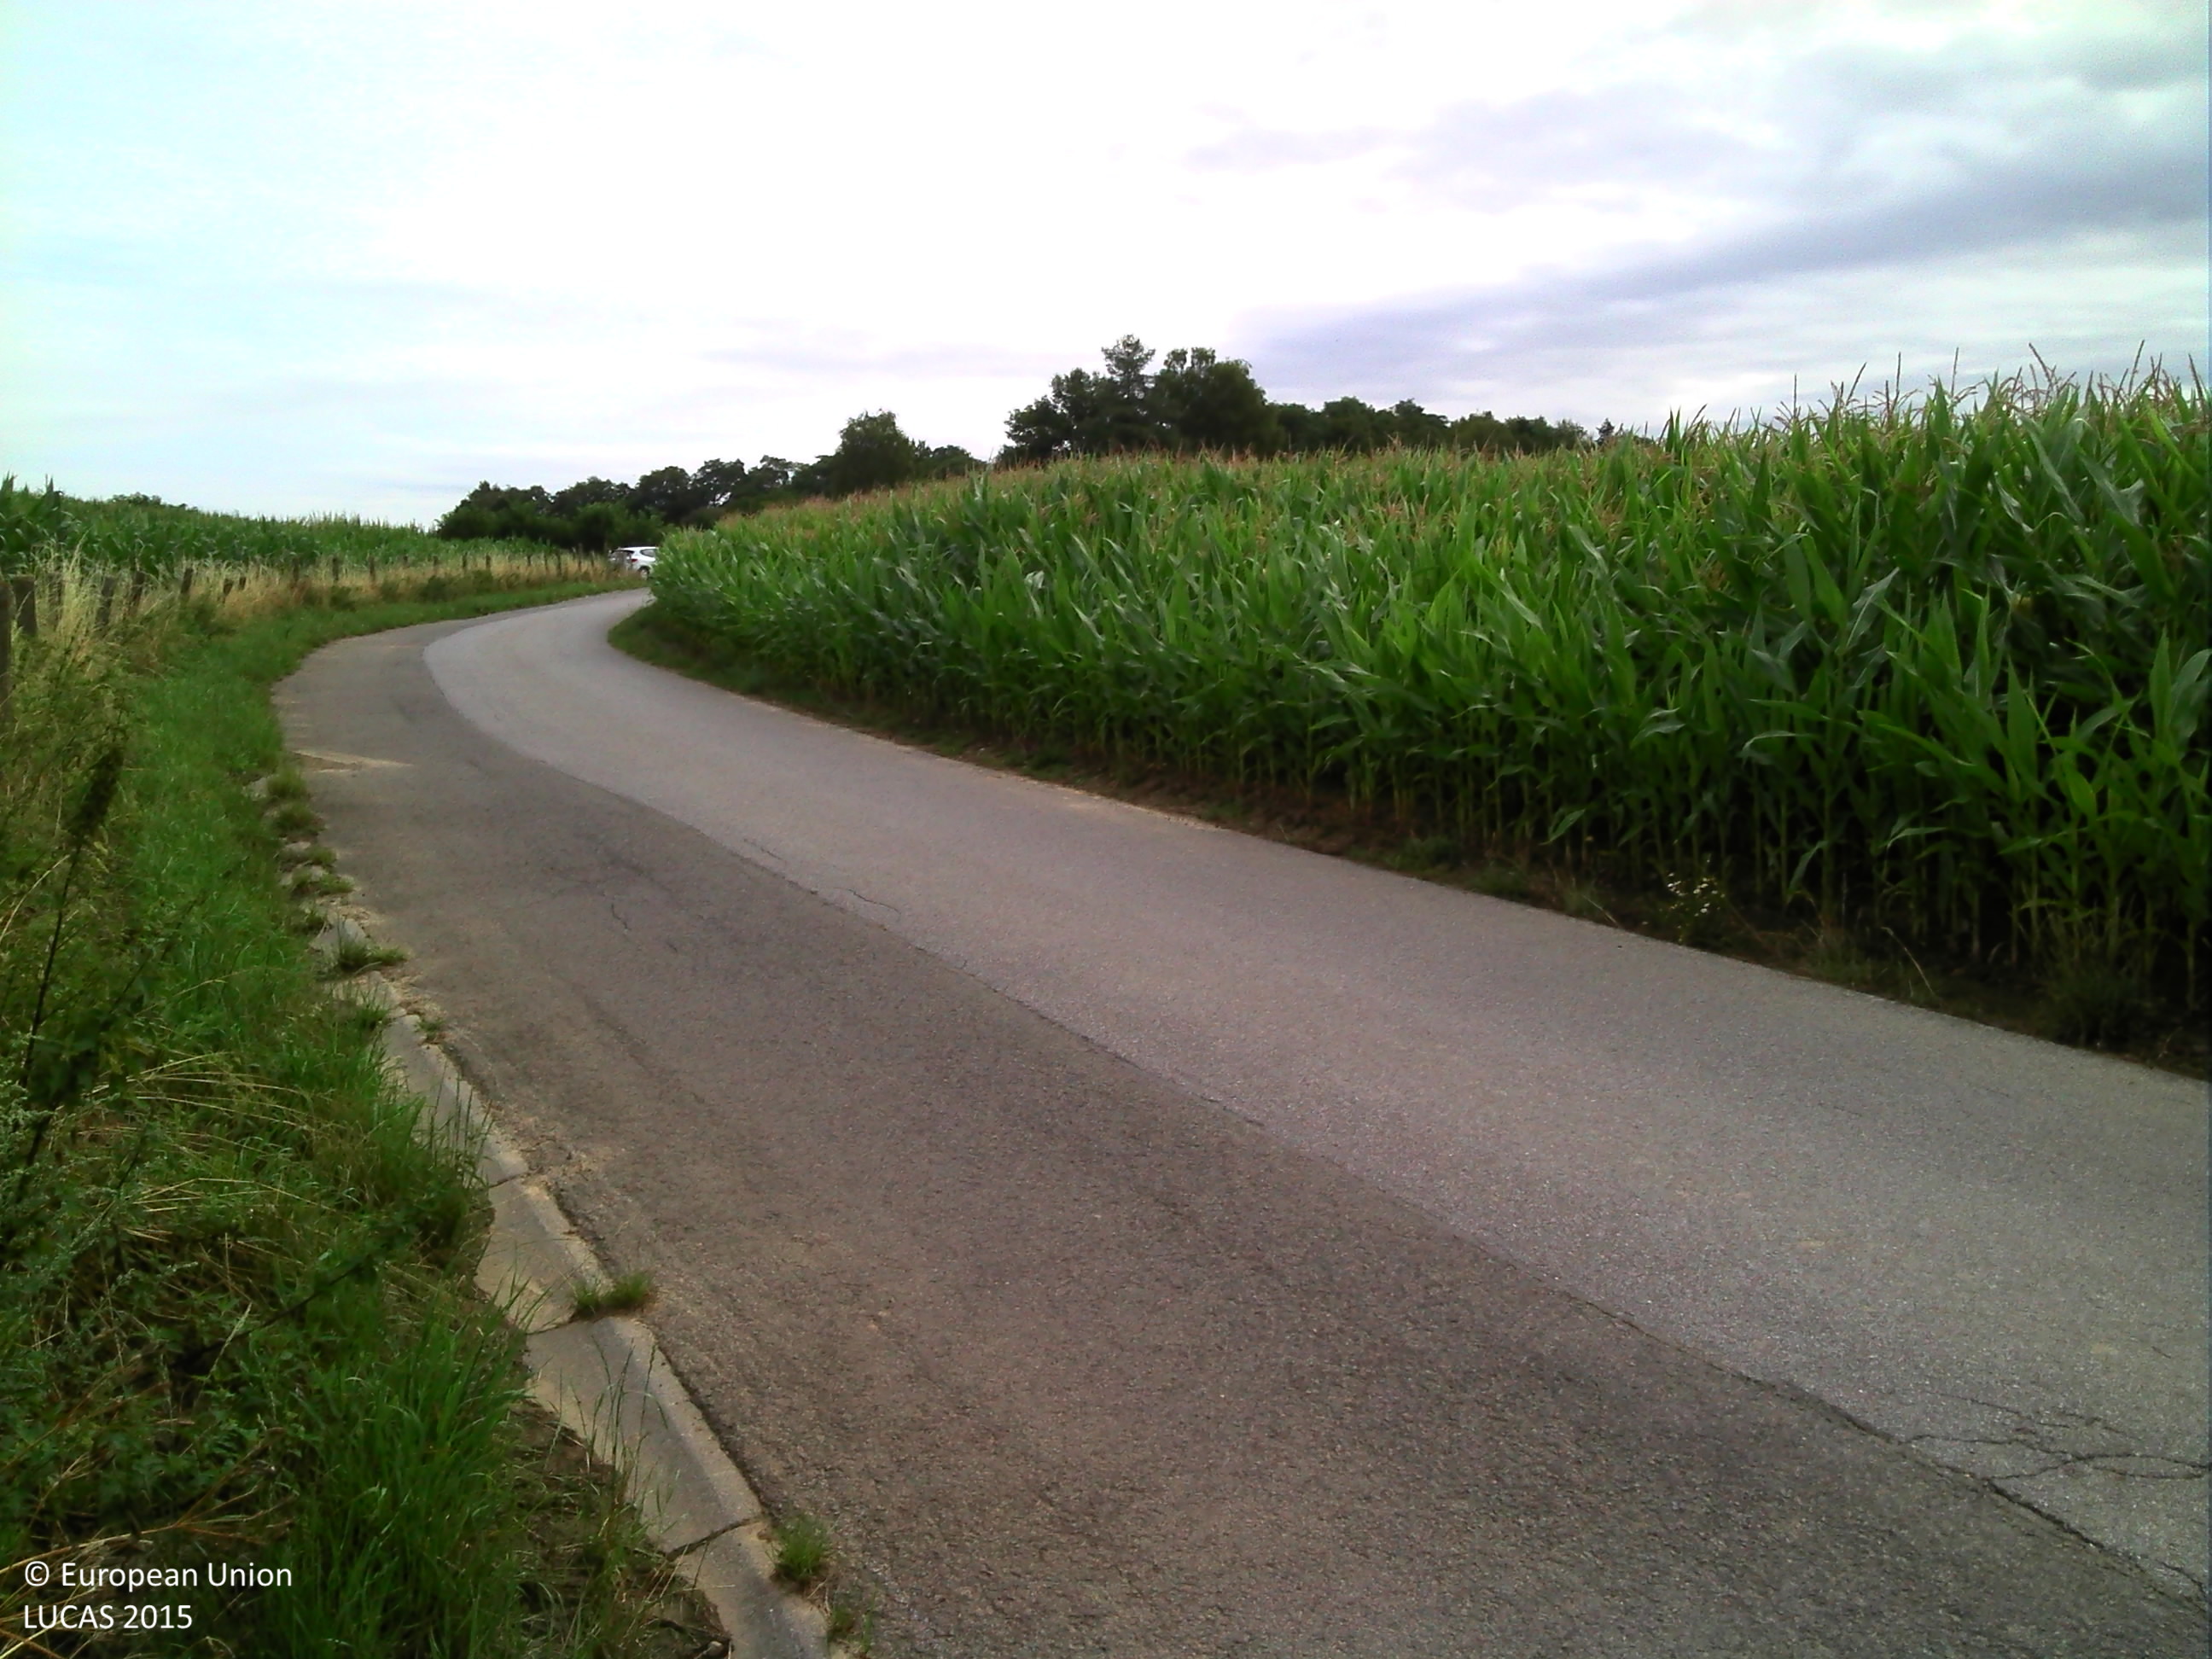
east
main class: Cropland
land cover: Maize
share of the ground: > 75 %
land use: Agriculture (excluding fallow land and kitchen gardens)
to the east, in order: Maize; Fences; Grass margins; Paved roads, cycling and walking lanes; Grass margins; Maize; Grass margins; Fences; Grass margins; Potatoes; Grass margins; Fences; Grass margins; Potatoes
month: July
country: BE
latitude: 50.7526
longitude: 5.7321
